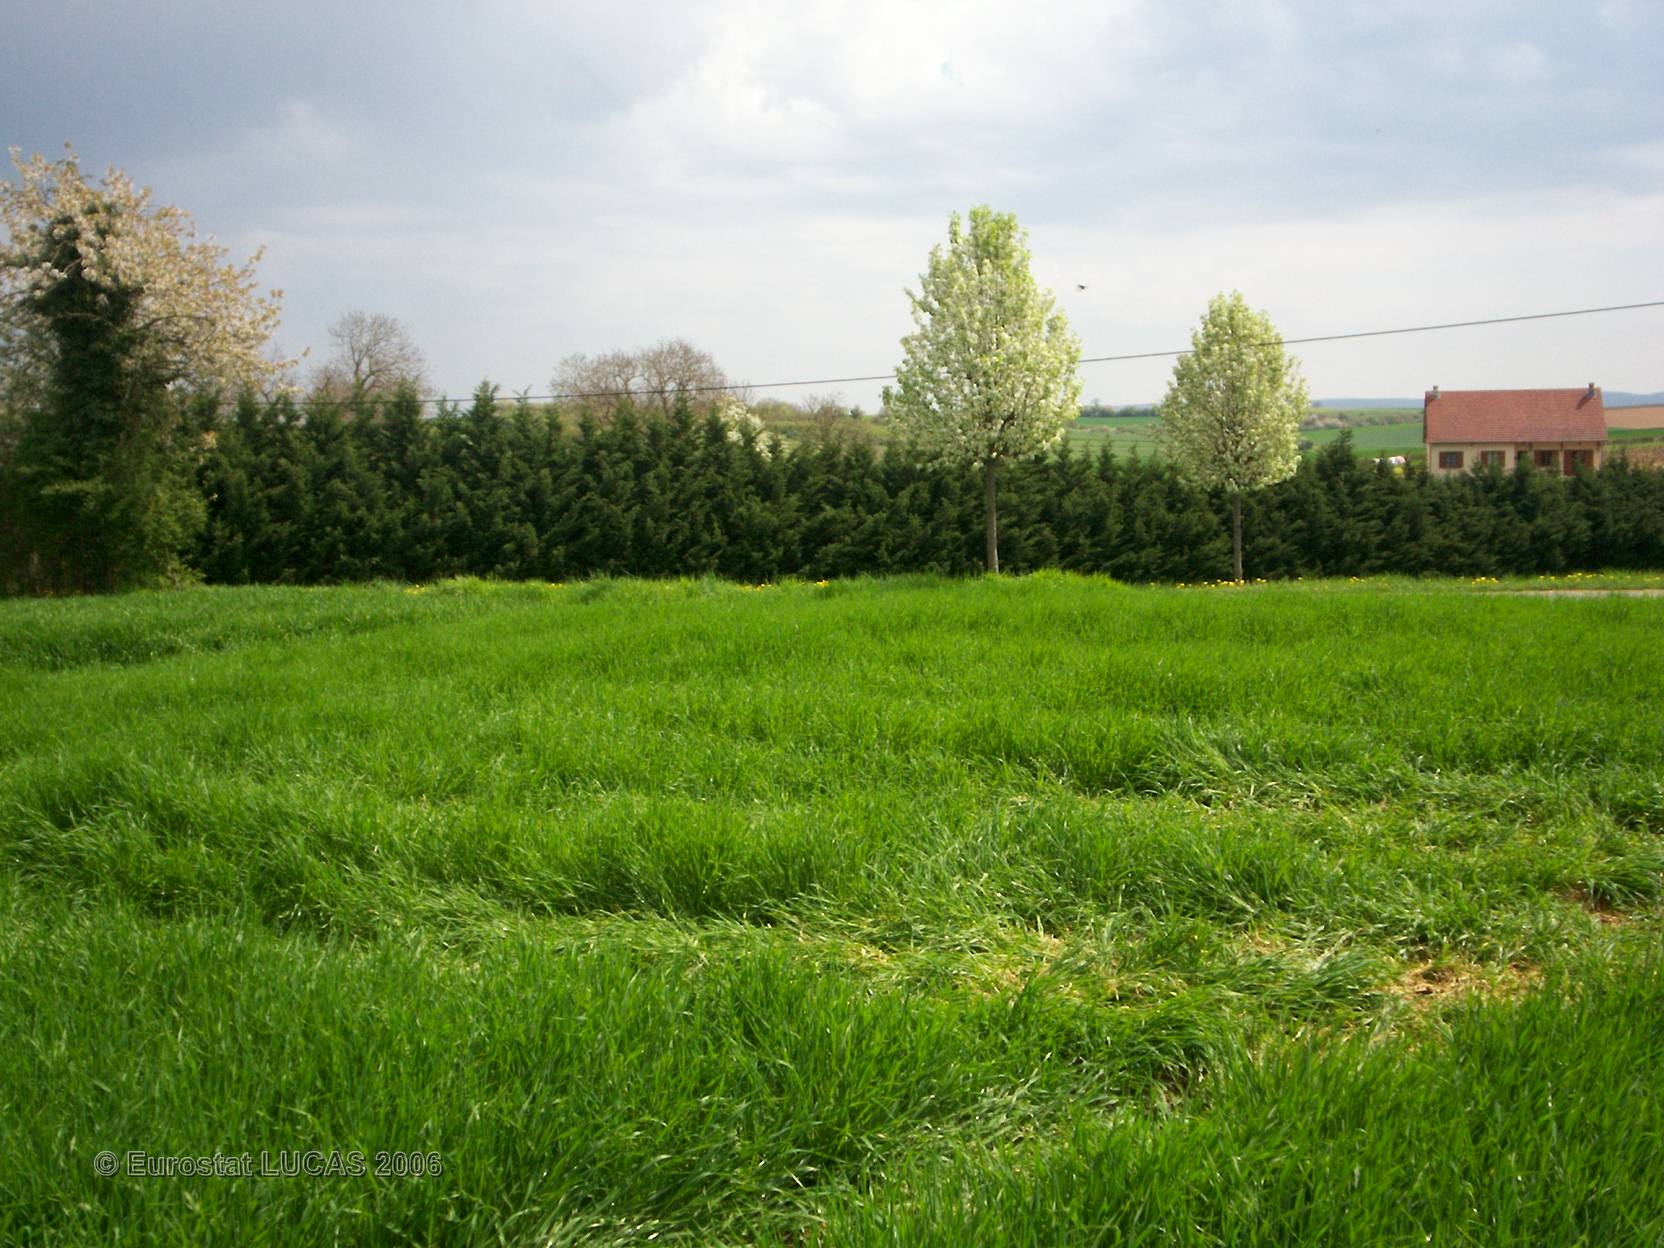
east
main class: Cropland
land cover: Barley
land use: Agriculture (excluding fallow land and kitchen gardens)
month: April
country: FR
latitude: 47.3339
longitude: 3.0207
